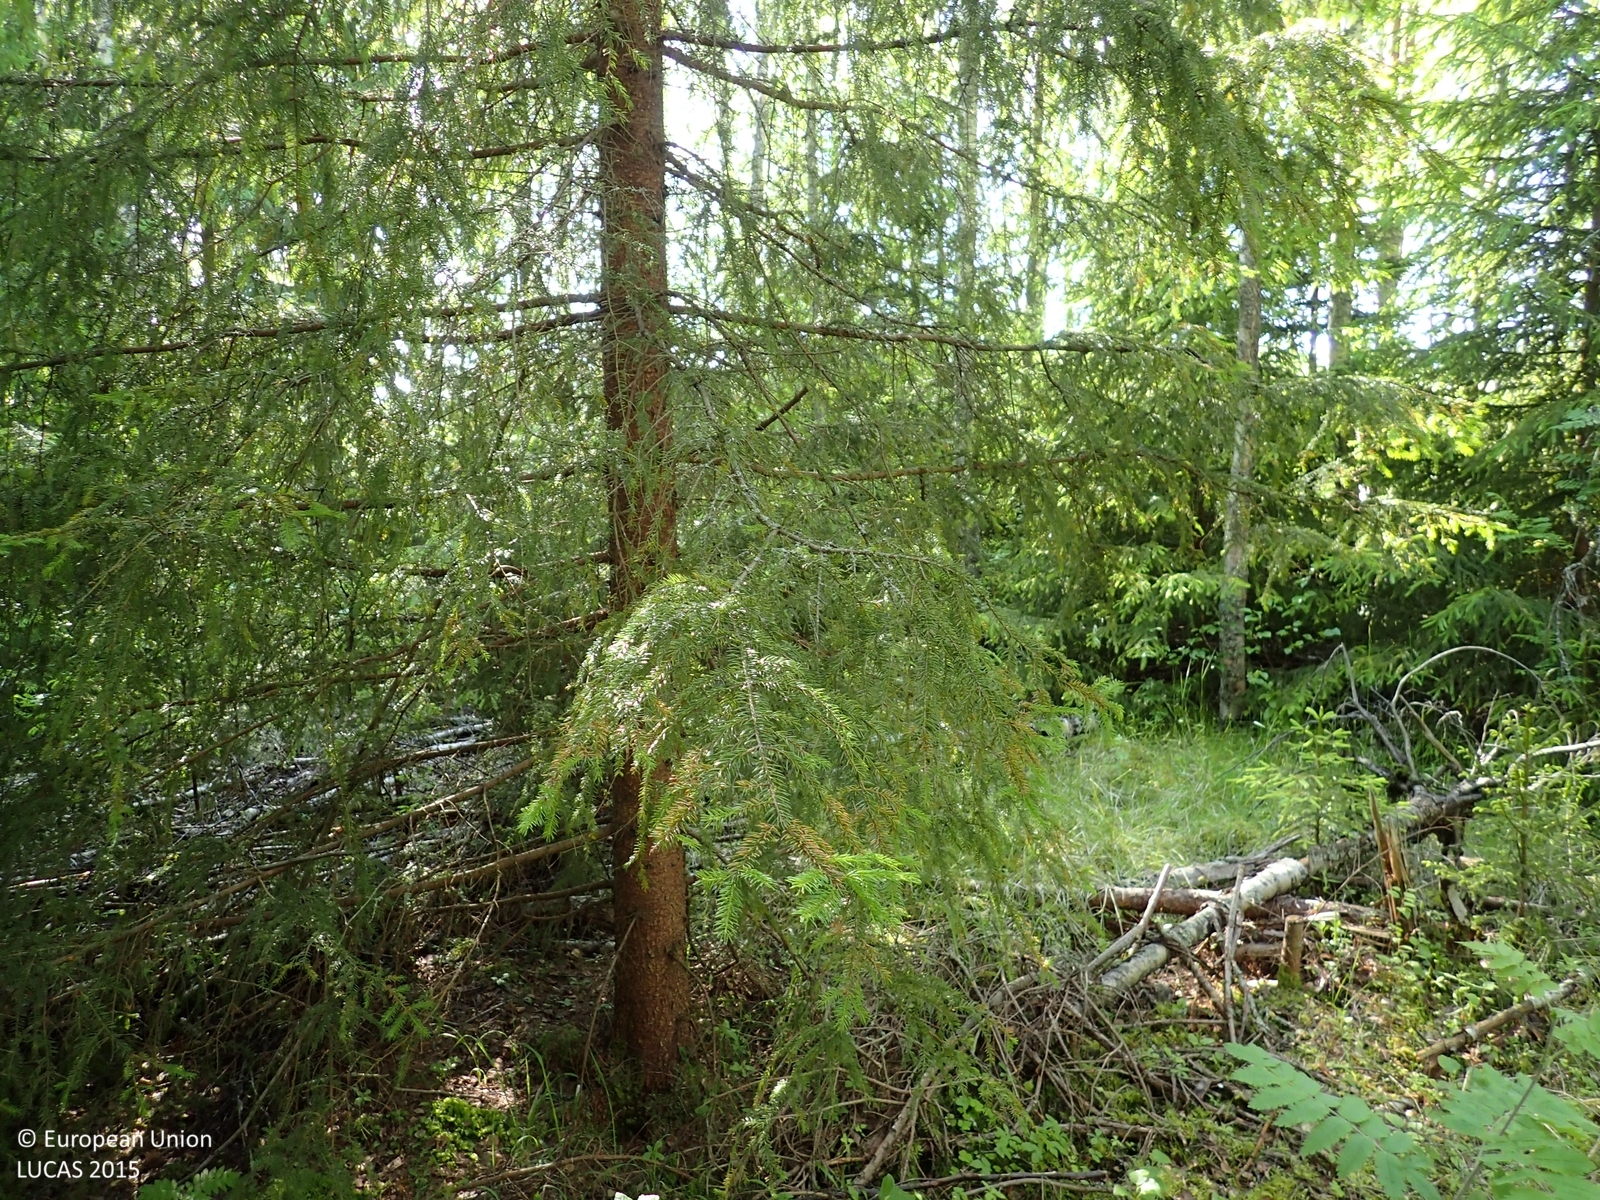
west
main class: Woodland
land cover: Other mixed woodland
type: boreal forest
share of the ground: > 75 %
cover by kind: coniferous forest trees 50 %, broadleaved forest trees 25 %, herbaceous plants 20 %, lichens and mosses 5 %
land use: Forestry
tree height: > 5 m
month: June
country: FI
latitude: 62.4442
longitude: 21.2601
